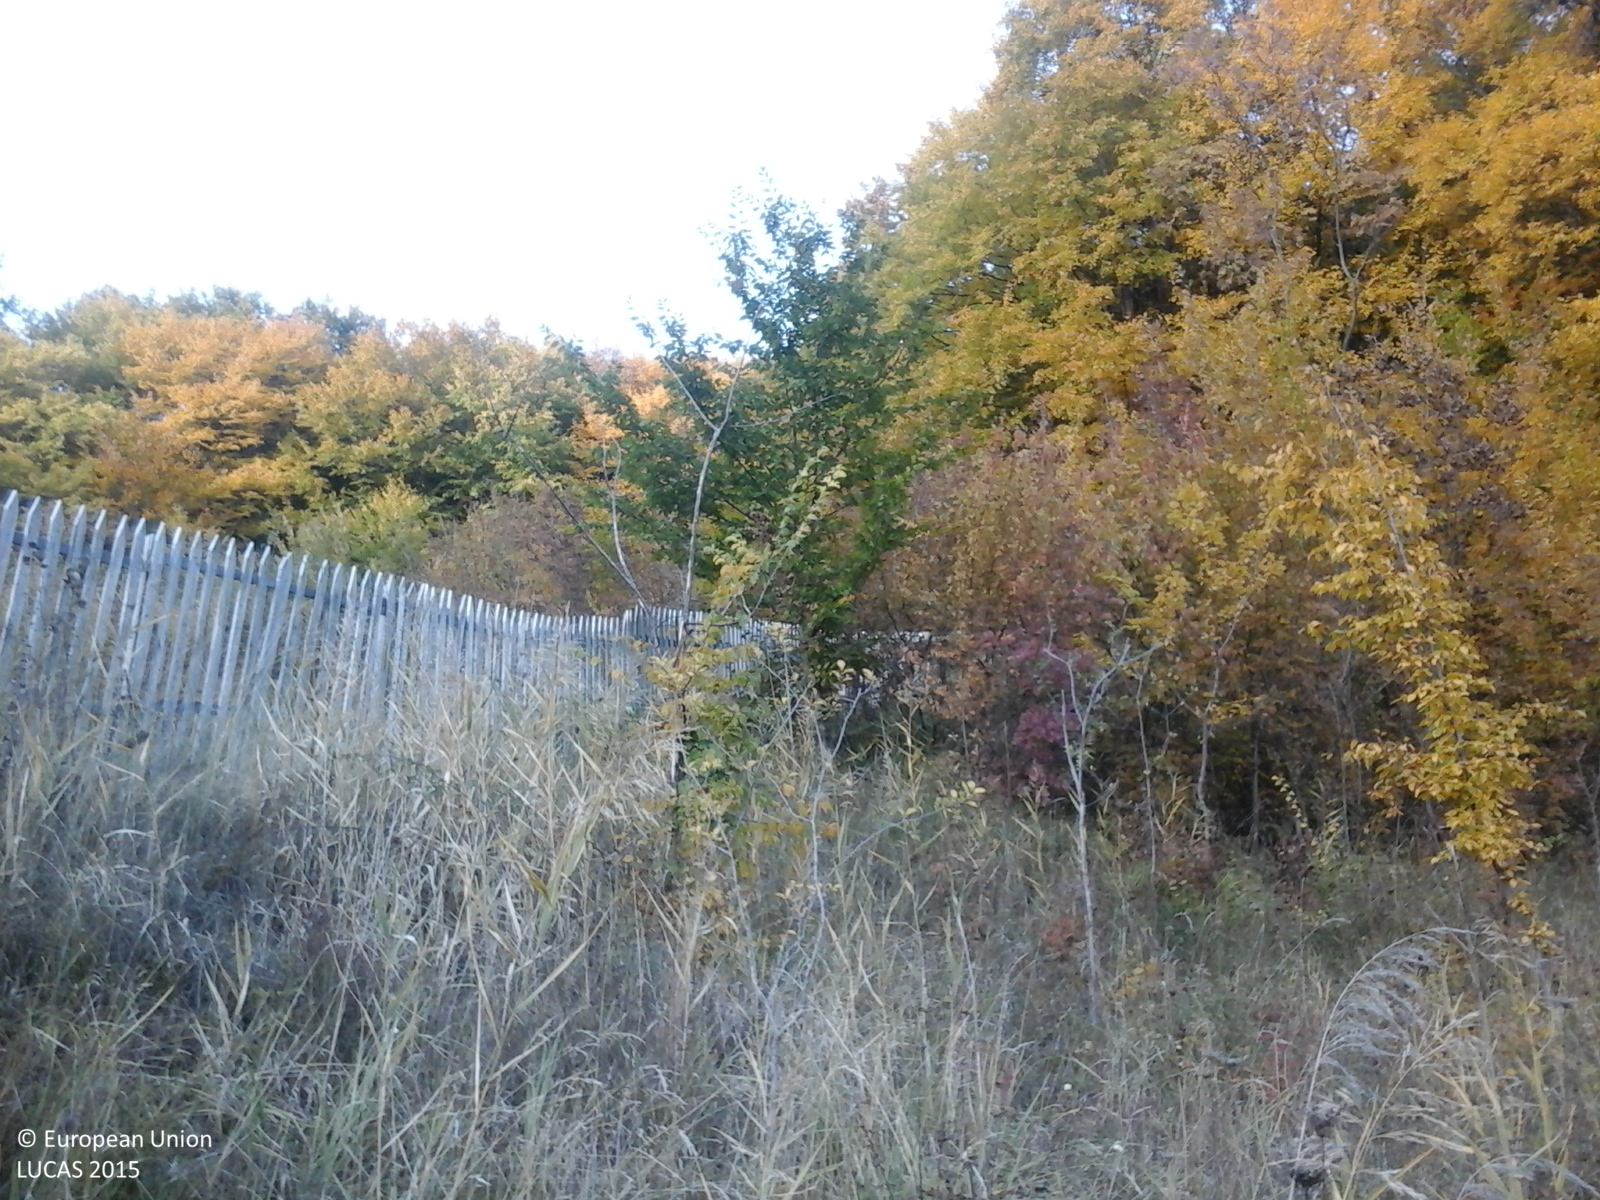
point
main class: Woodland
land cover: Broadleaved woodland
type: acidophilous oak and oak-birch forest
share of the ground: > 75 %
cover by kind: broadleaved forest trees 100 %
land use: Forestry
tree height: > 5 m
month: October
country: RO
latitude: 45.1967
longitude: 26.3227
